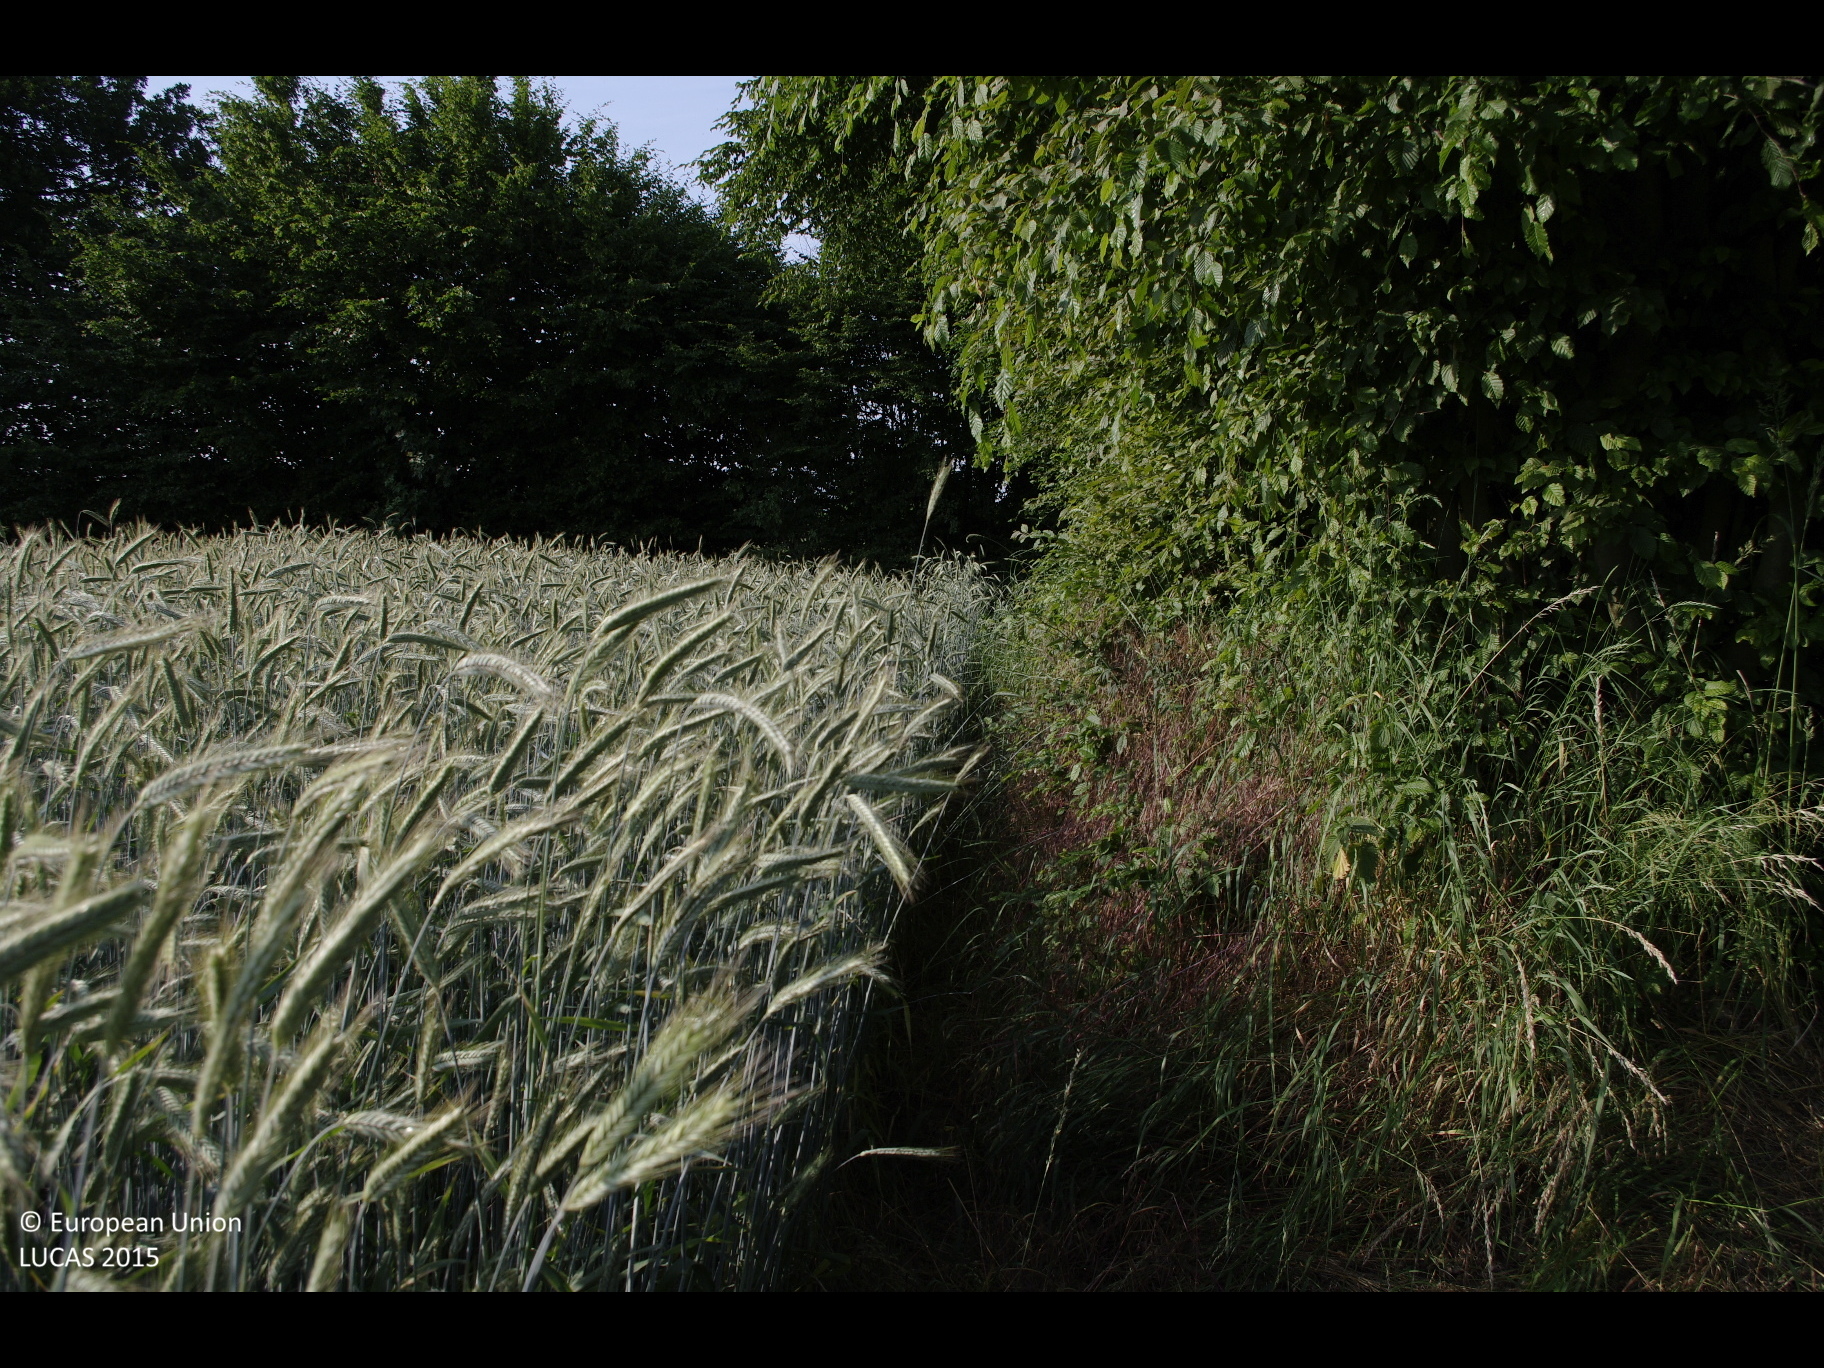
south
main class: Cropland
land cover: Rye
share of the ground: > 75 %
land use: Agriculture (excluding fallow land and kitchen gardens)
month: July
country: DE
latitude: 53.7957
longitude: 10.6221
